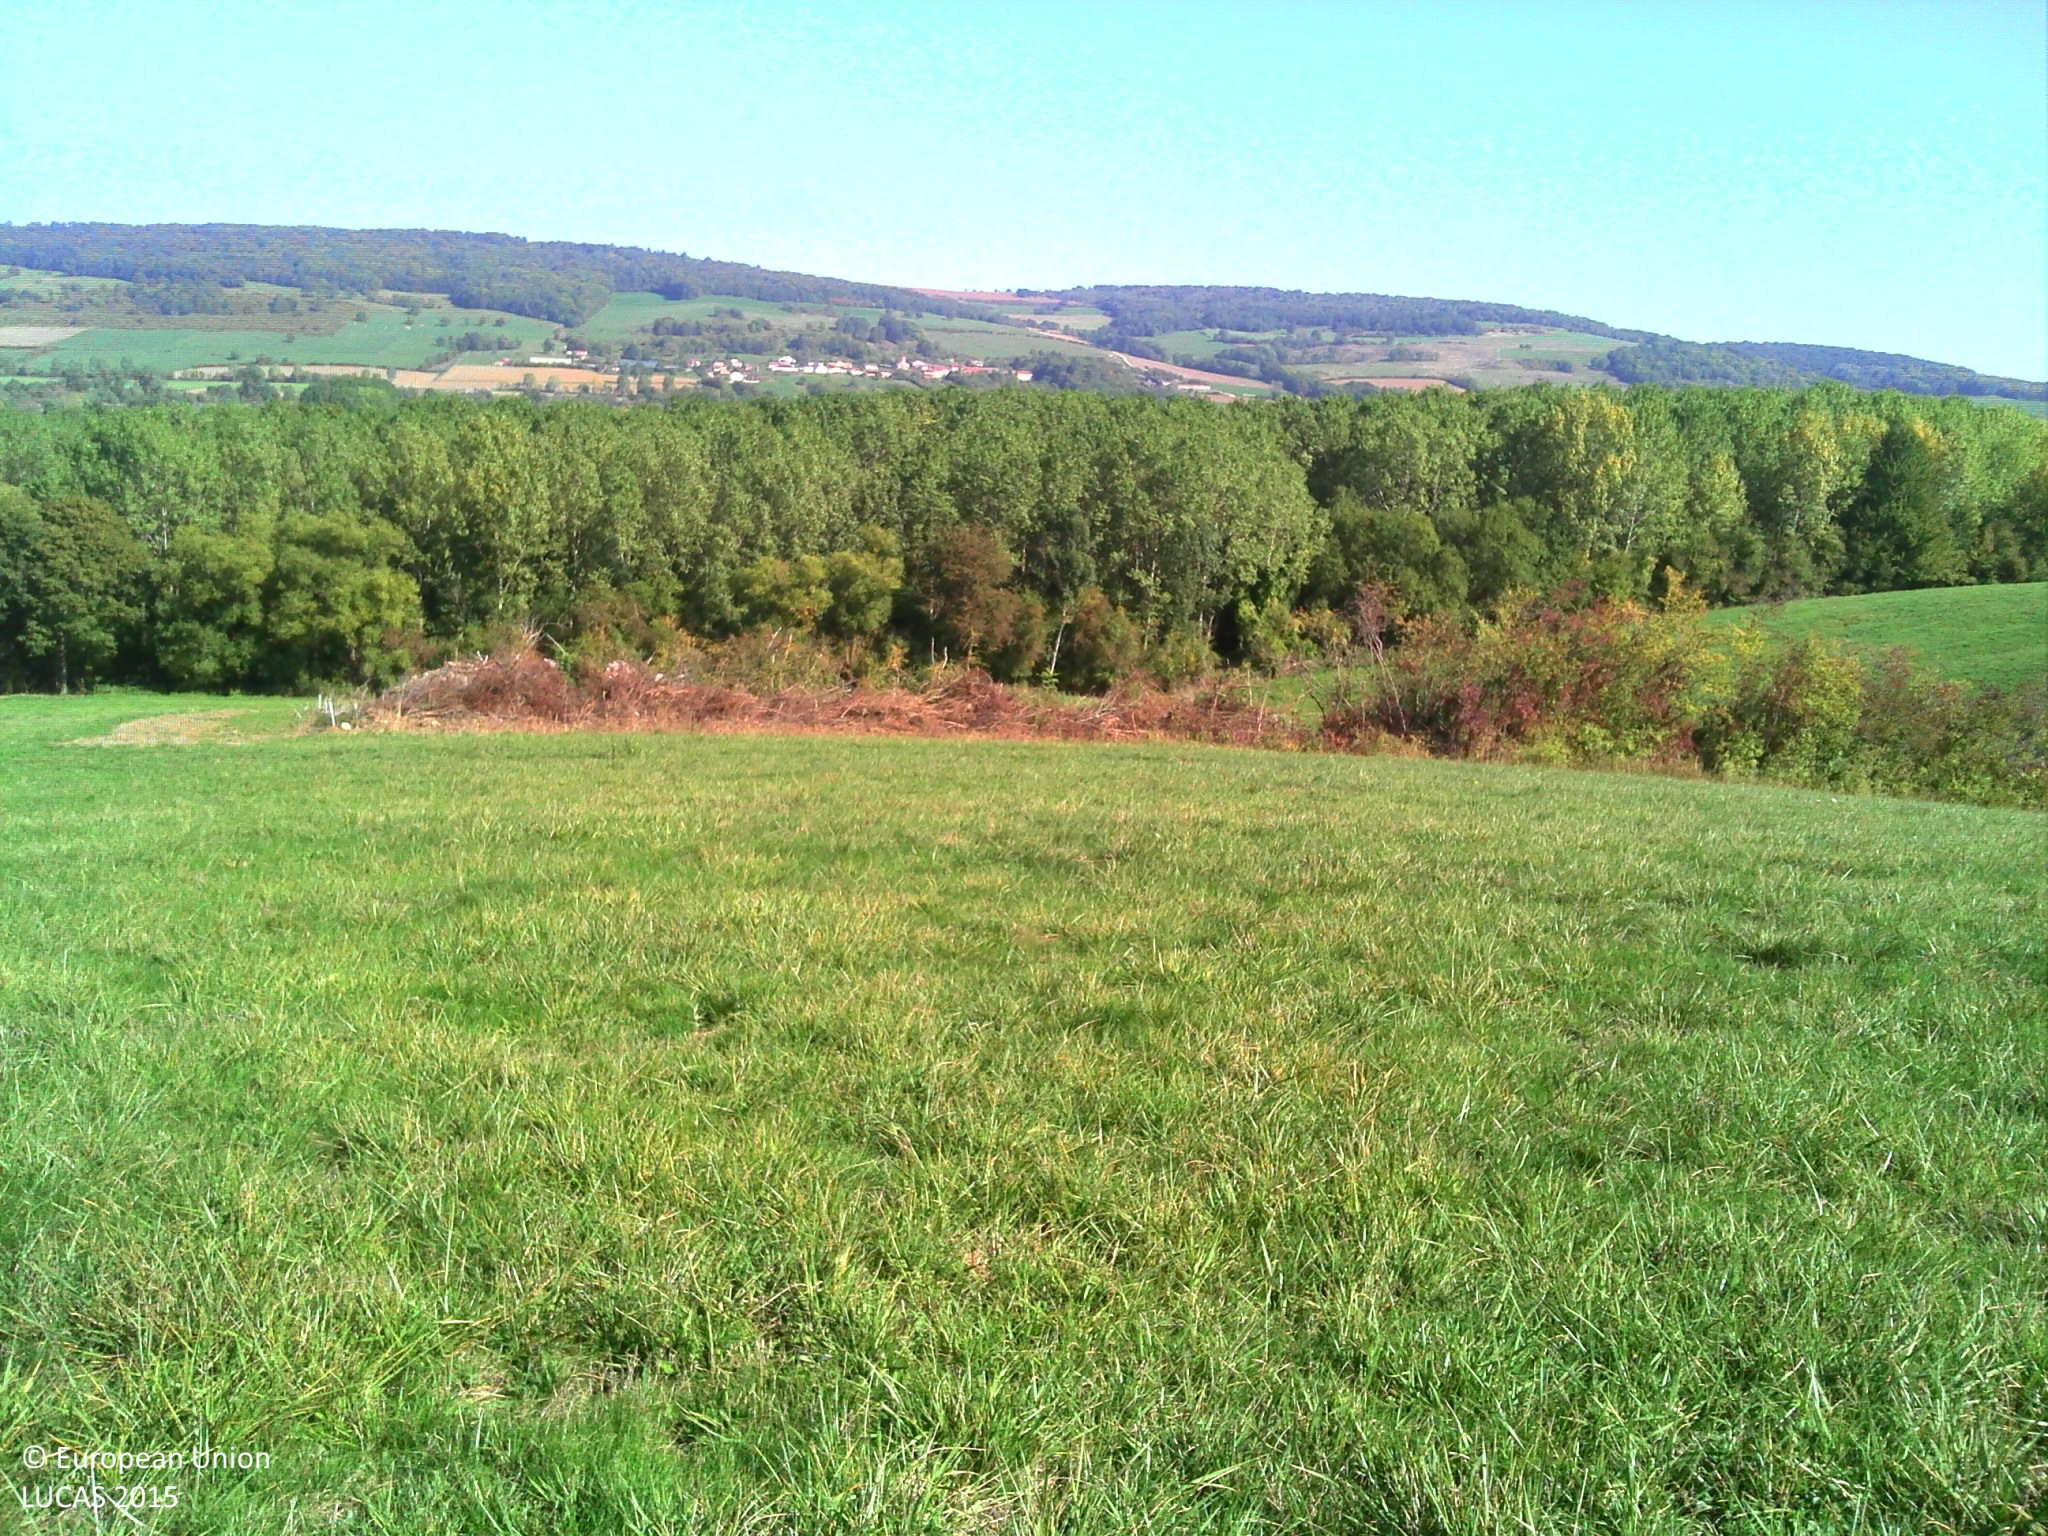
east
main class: Grassland
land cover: Grassland without tree/shrub cover
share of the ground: > 75 %
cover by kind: herbaceous plants 95 %, consolidated bare surface 5 %
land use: Agriculture (excluding fallow land and kitchen gardens)
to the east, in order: Grassland without tree/shrub cover; Shrubland without tree cover; Other bare soil; Temporary grasslands; Rivers and streams; Temporary grasslands; Broadleaved woodland
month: October
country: FR
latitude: 48.9625
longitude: 6.0250
